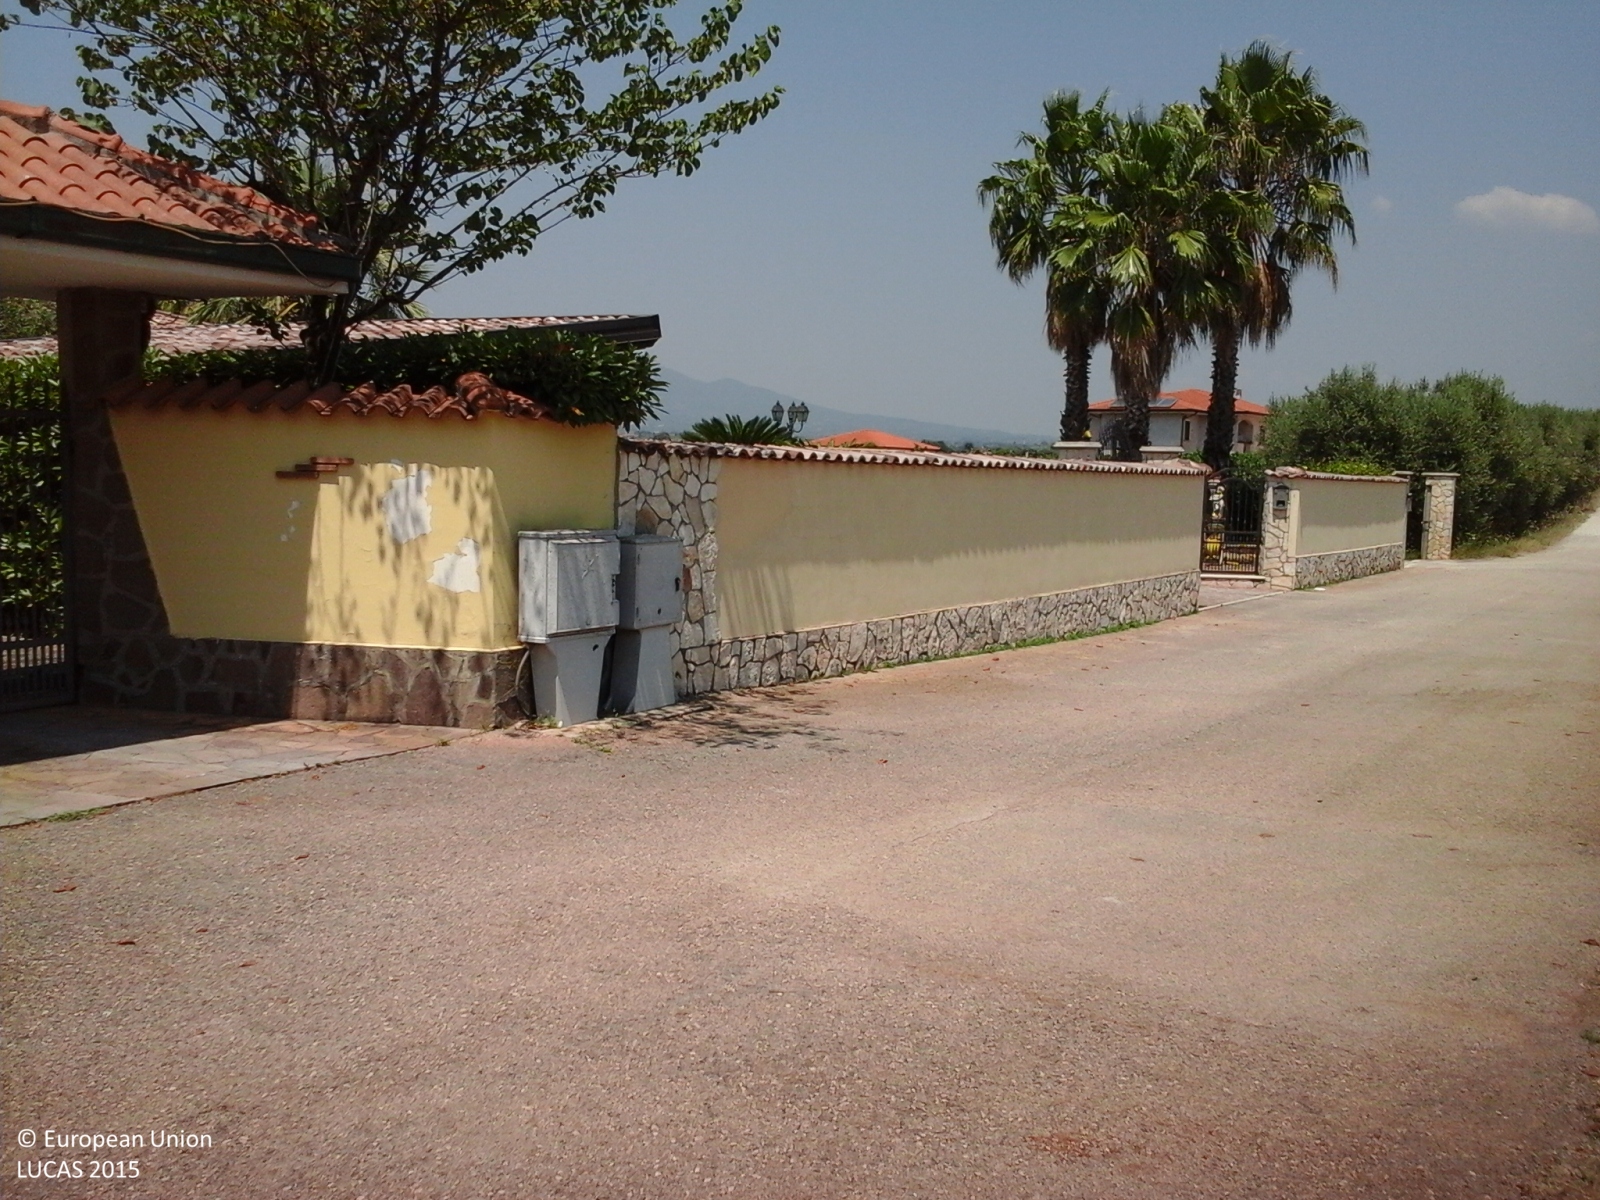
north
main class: Cropland
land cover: Other fruit trees and berries
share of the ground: > 75 %
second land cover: Grassland without tree/shrub cover
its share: > 75 %
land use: Agriculture (excluding fallow land and kitchen gardens)
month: July
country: IT
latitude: 41.6027
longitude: 12.8087
